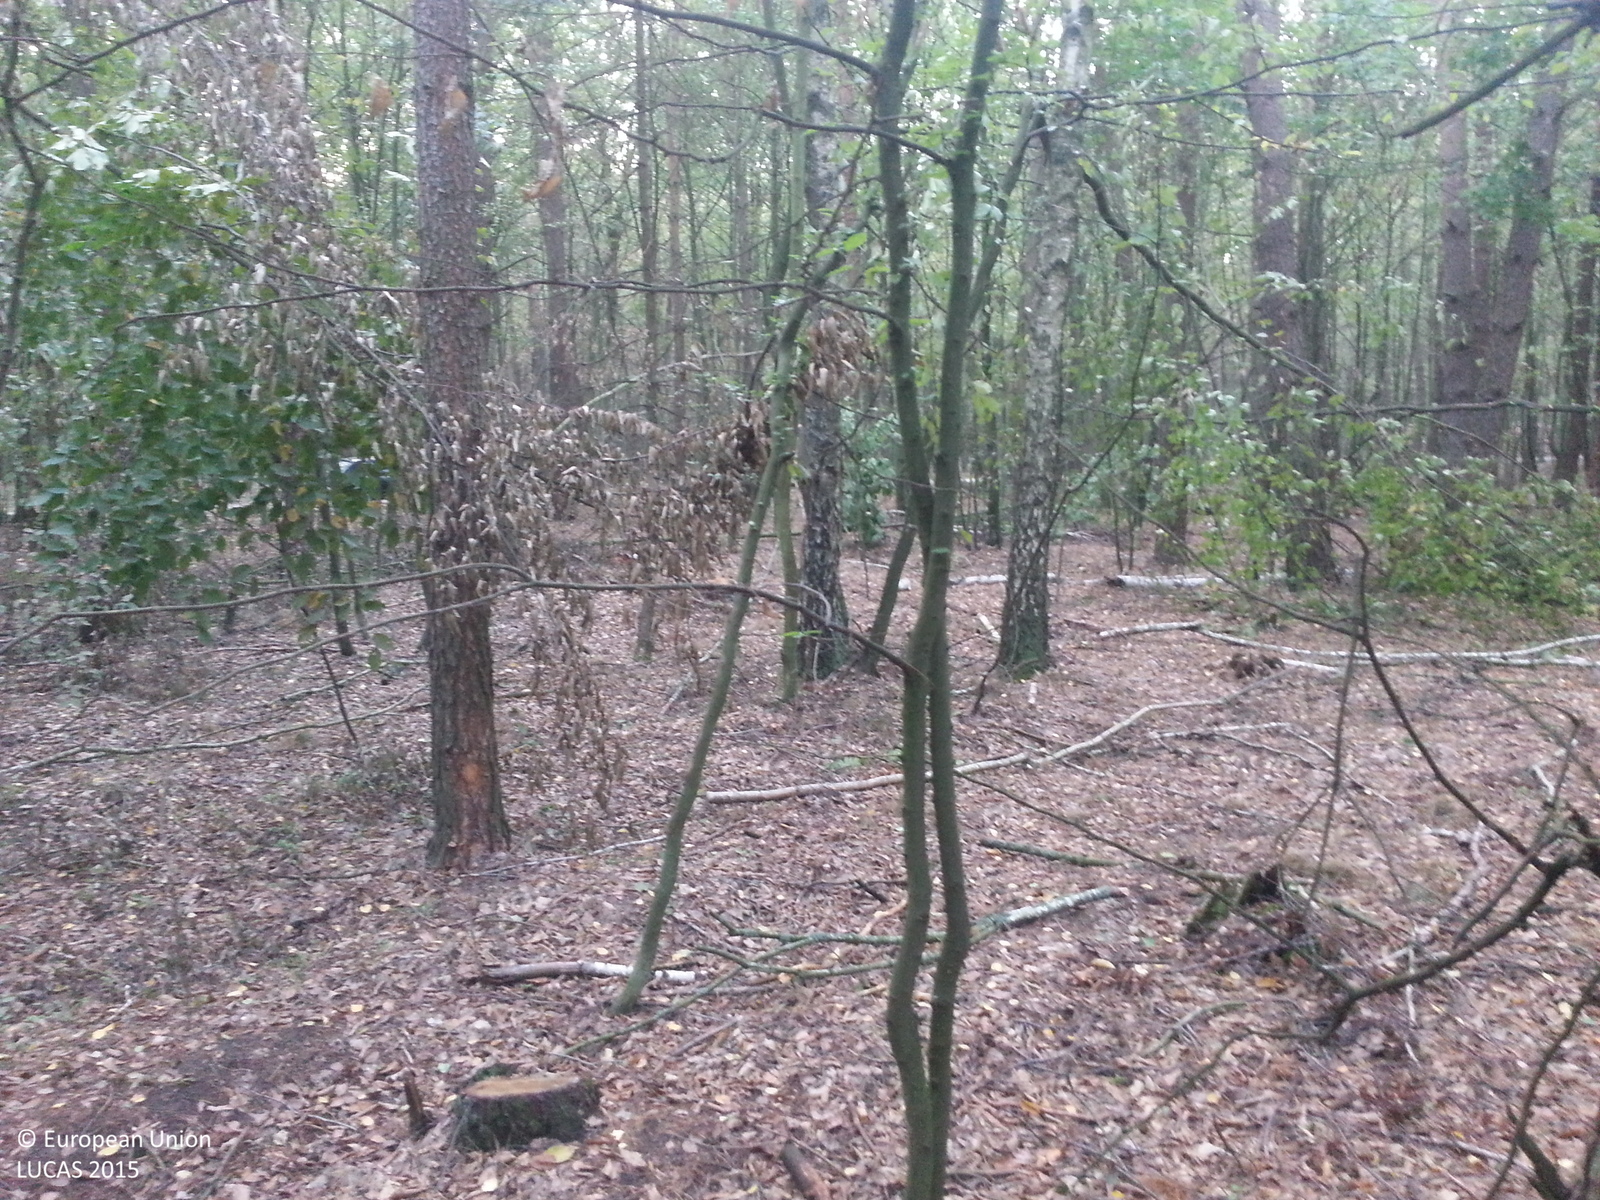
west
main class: Woodland
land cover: Other mixed woodland
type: hemiboreal forest and nemoral coniferous forest and mixed broadleaved-coniferous forest
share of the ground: > 75 %
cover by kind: broadleaved forest trees 45 %, coniferous forest trees 30 %, unconsolidated bare surface 20 %, herbaceous plants 5 %
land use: Forestry
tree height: > 5 m
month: September
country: PL
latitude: 53.1804
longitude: 19.1664
